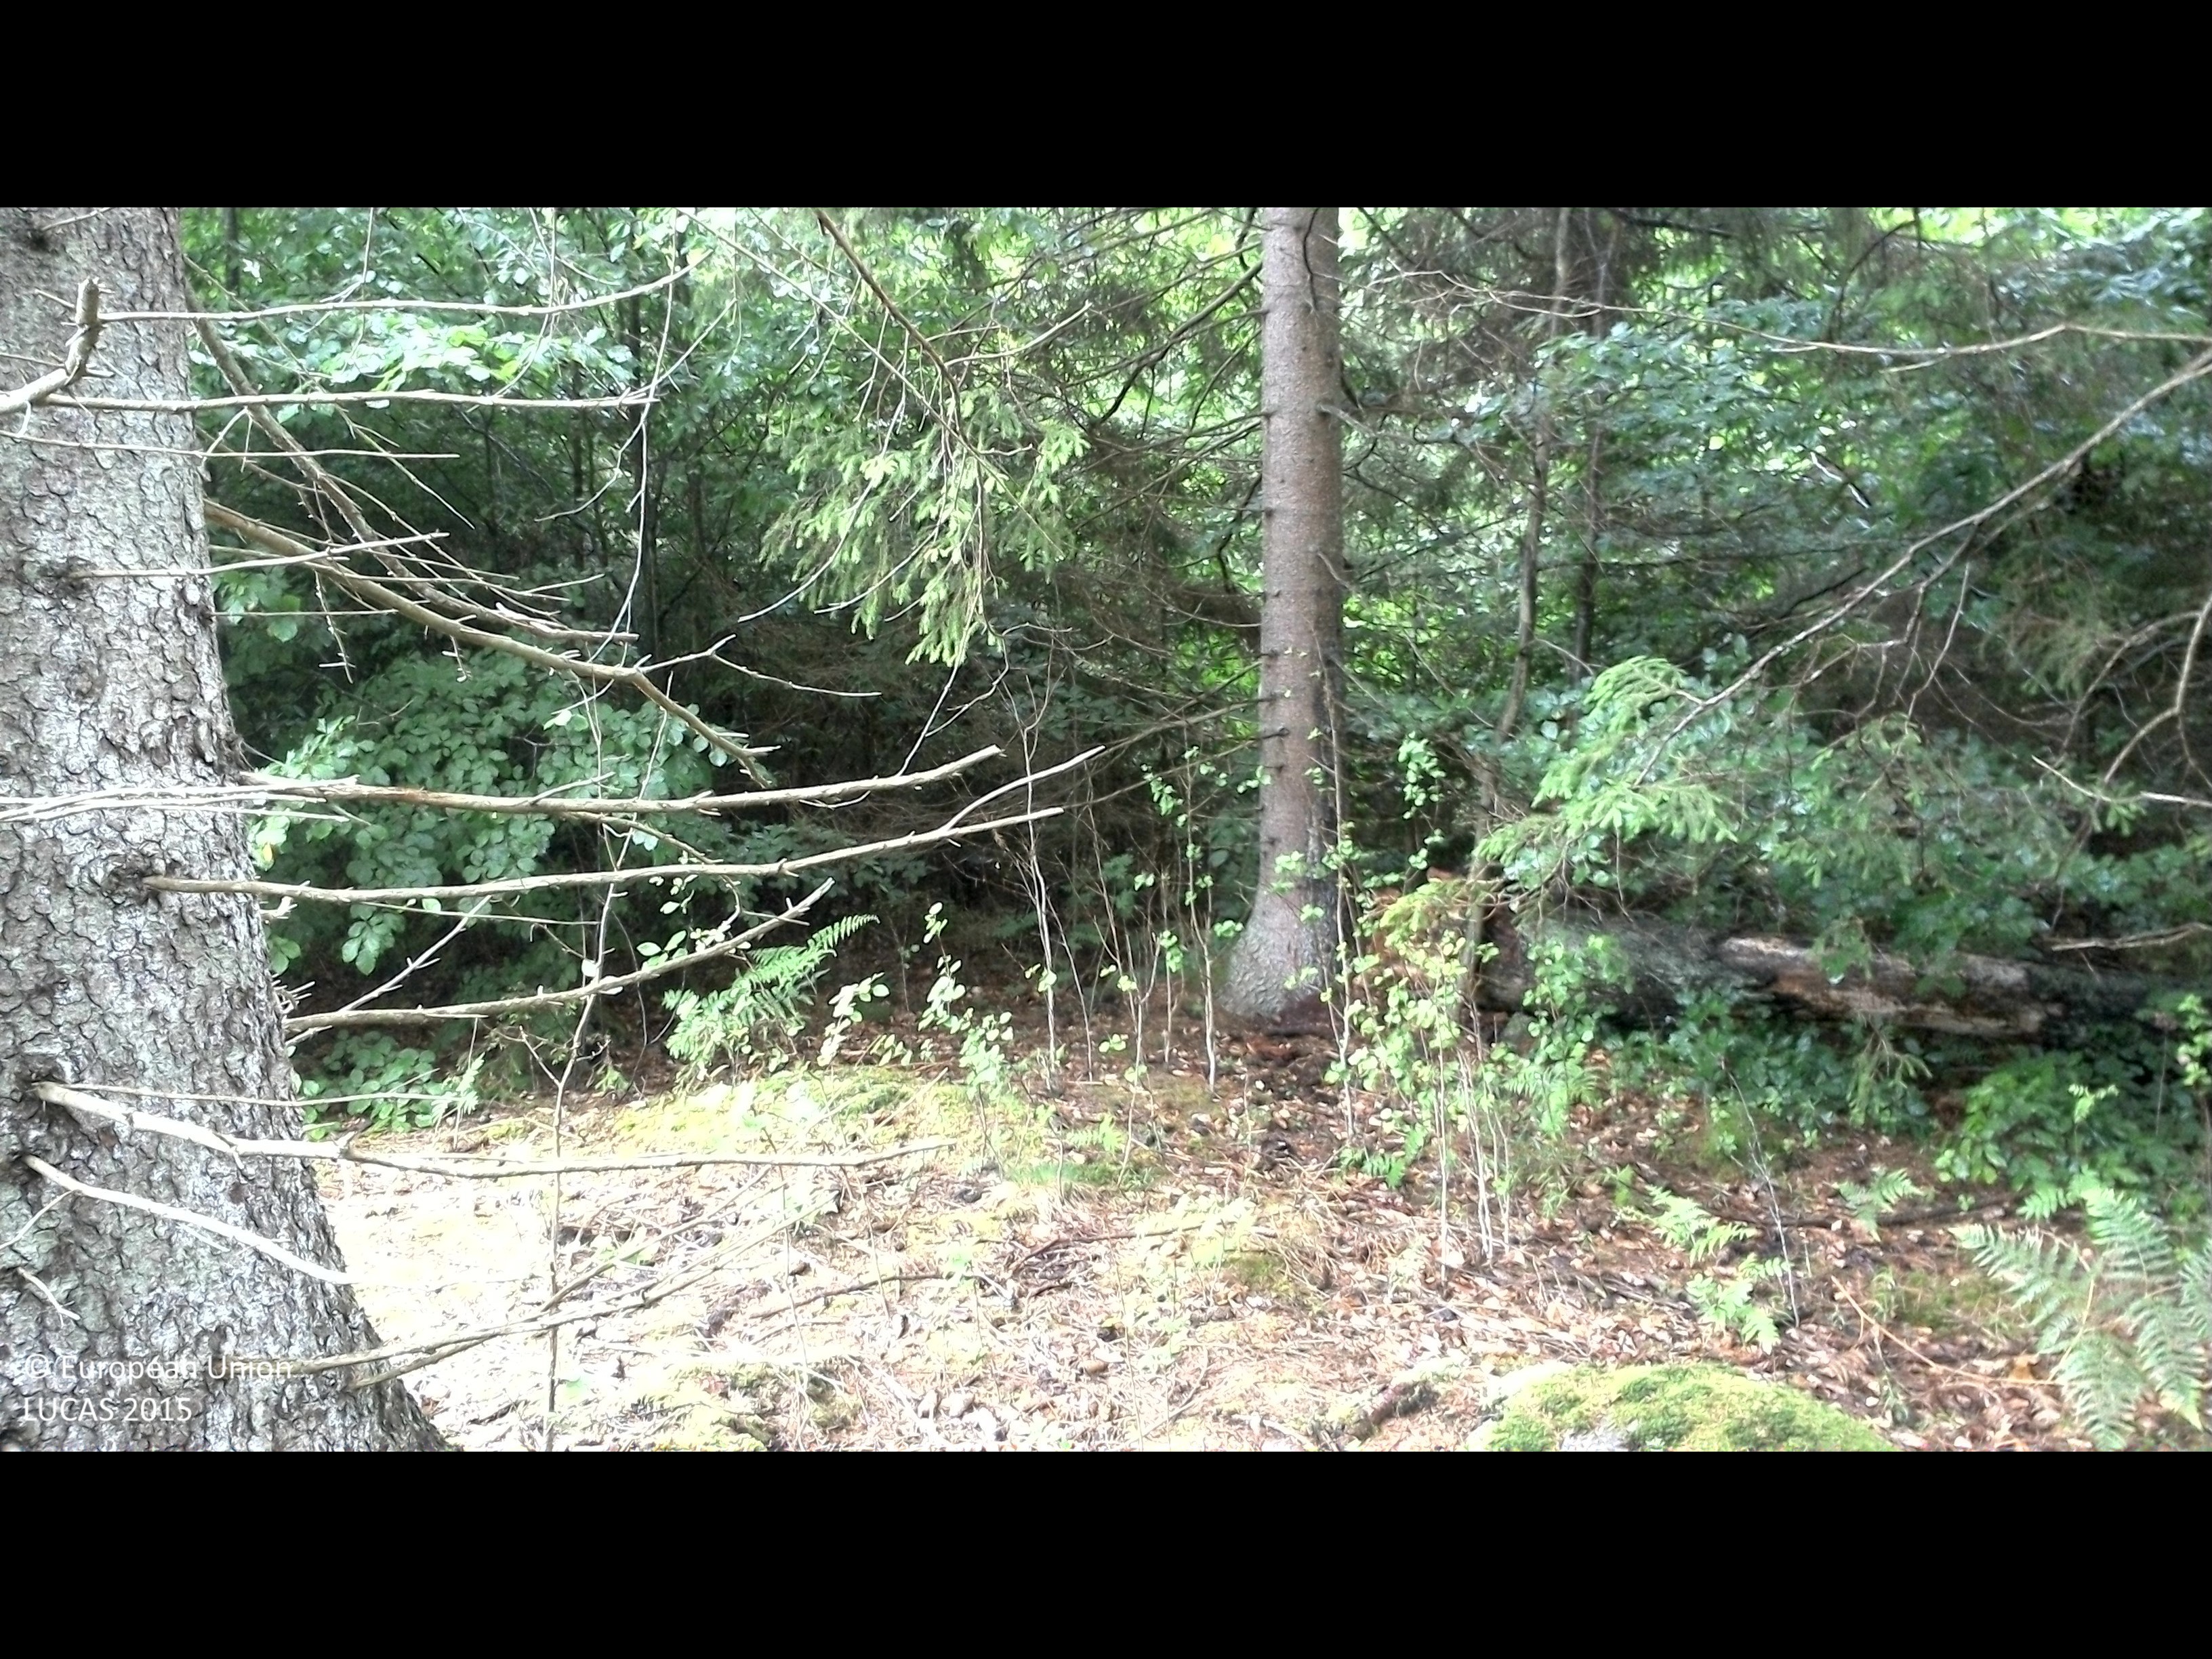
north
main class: Woodland
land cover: Spruce dominated coniferous woodland
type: boreal forest
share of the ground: > 75 %
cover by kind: coniferous forest trees 65 %, lichens and mosses 15 %, broadleaved forest trees 10 %, herbaceous plants 10 %
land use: Forestry
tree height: > 5 m
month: June
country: SE
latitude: 56.4284
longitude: 15.9511
